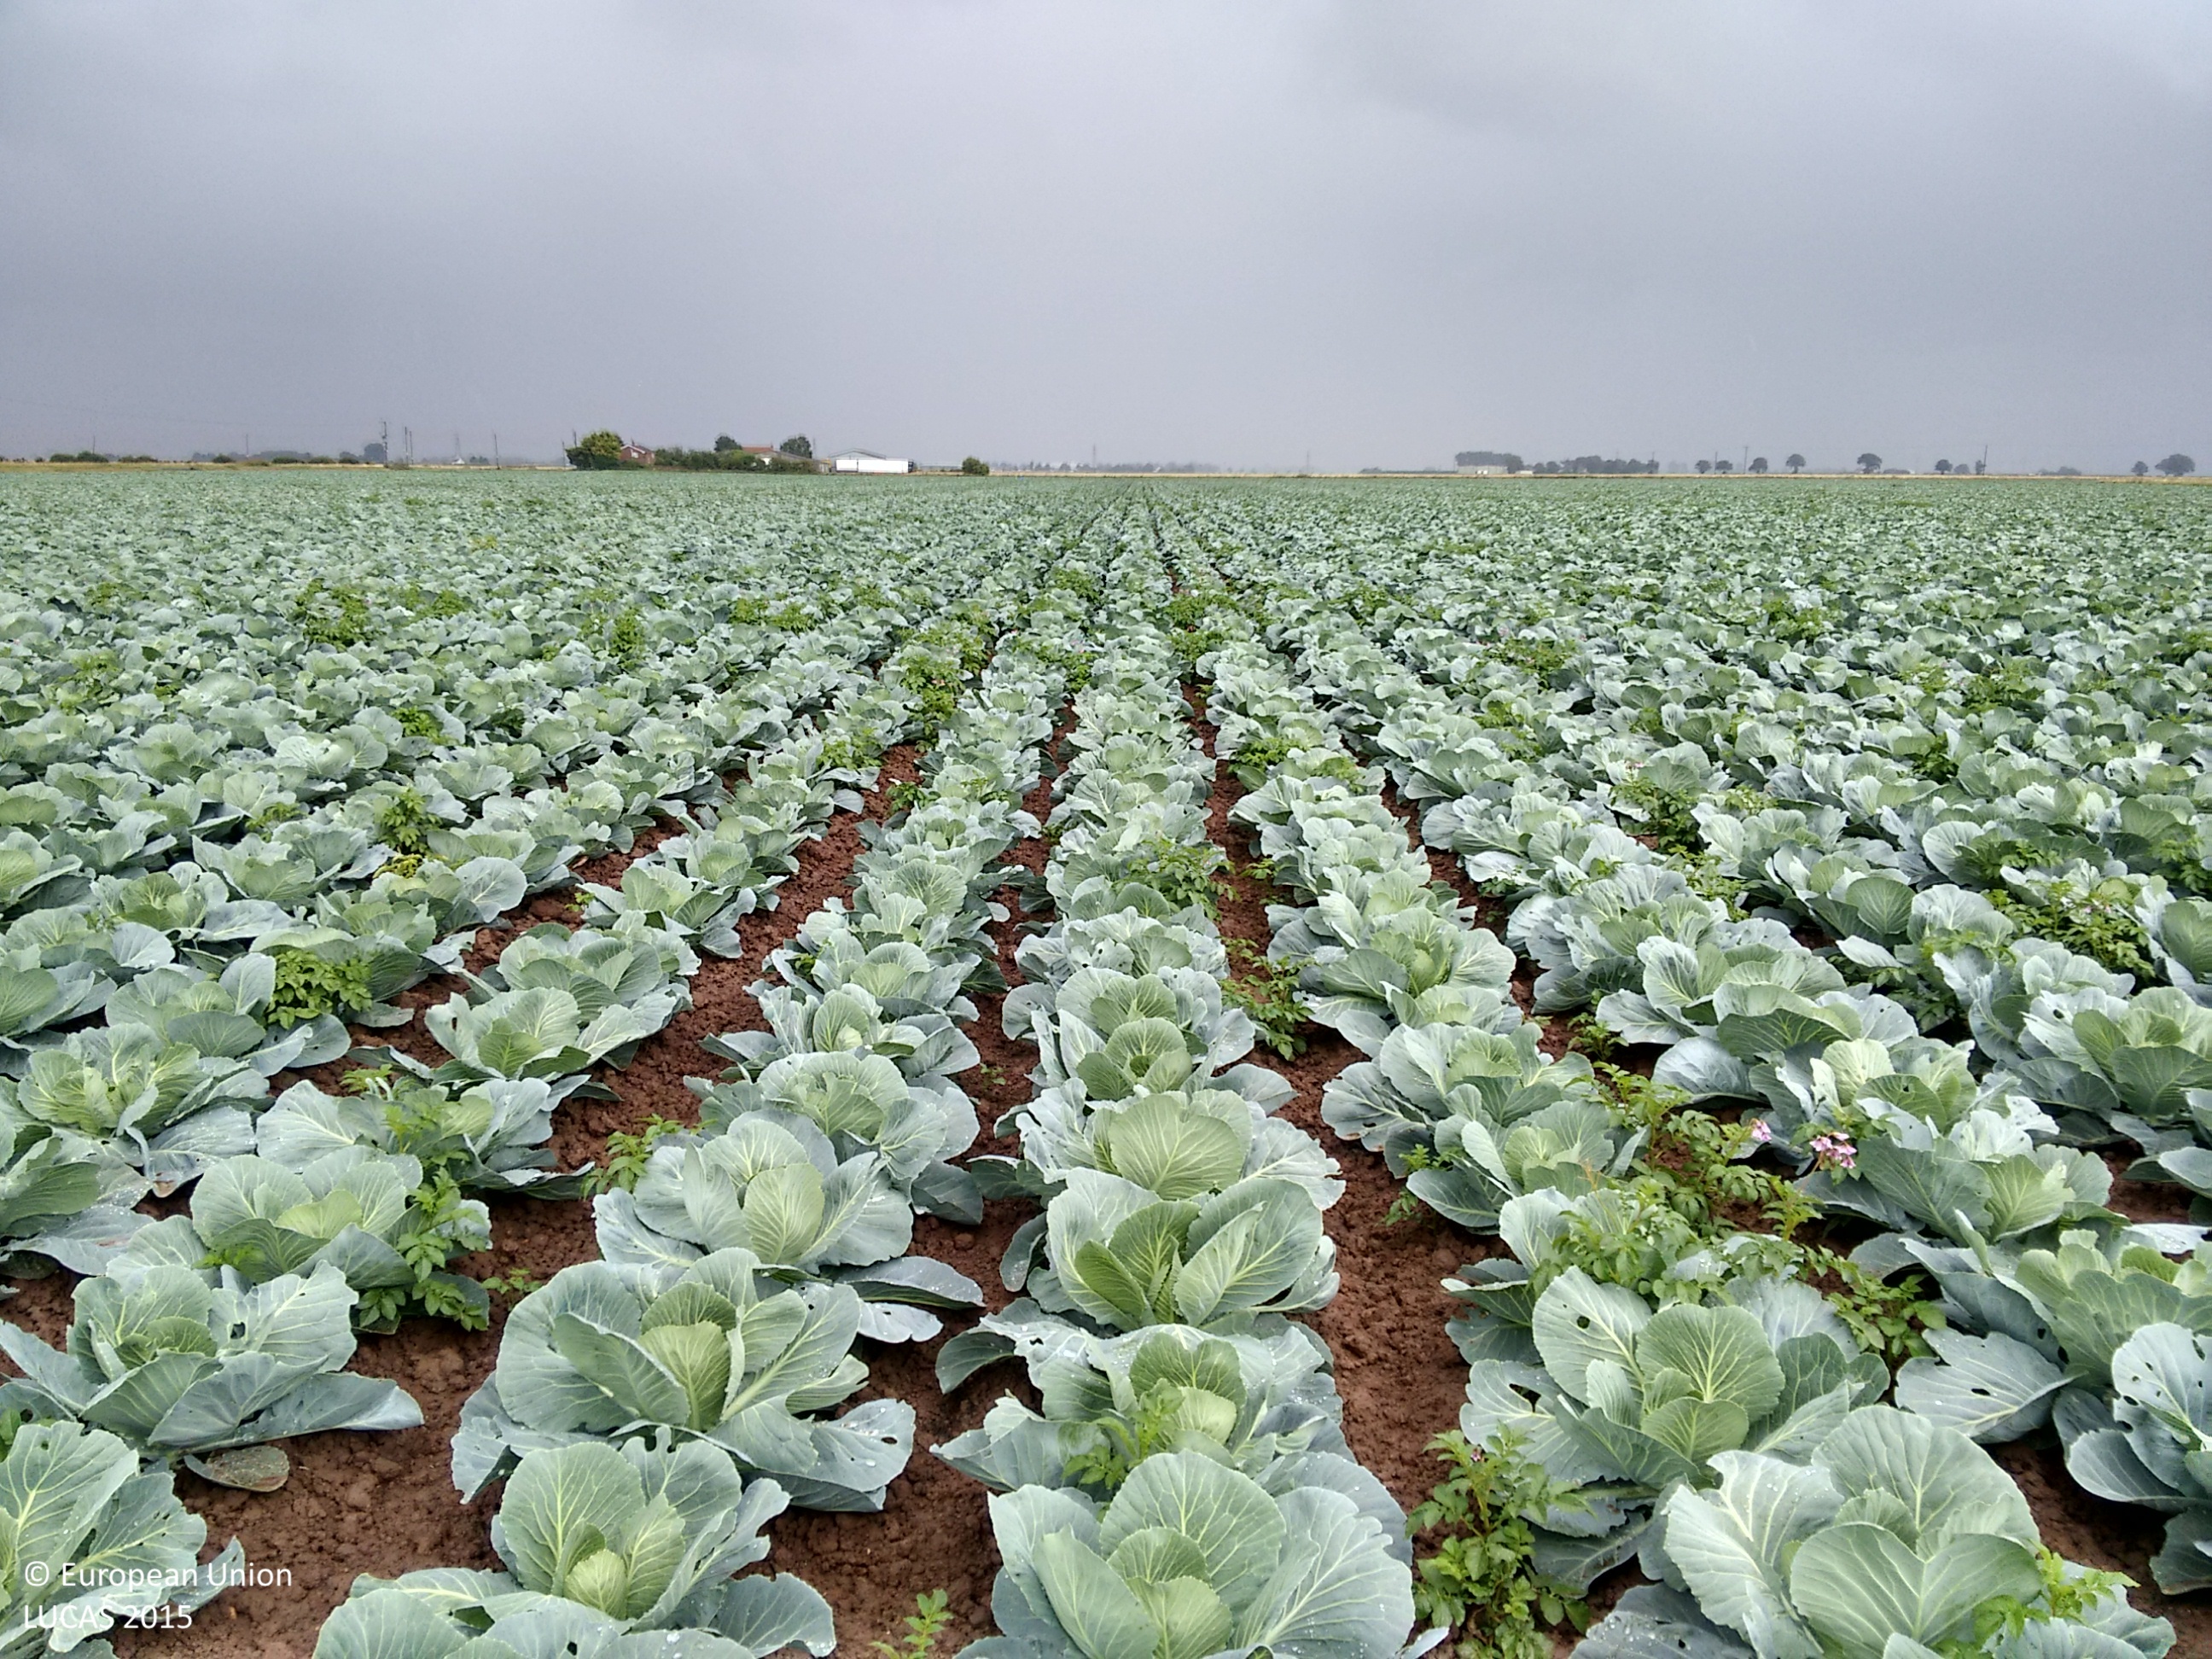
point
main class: Cropland
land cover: Other fresh vegetables
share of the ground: > 75 %
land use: Agriculture (excluding fallow land and kitchen gardens)
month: July
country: GB
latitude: 52.8578
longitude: -0.0279
